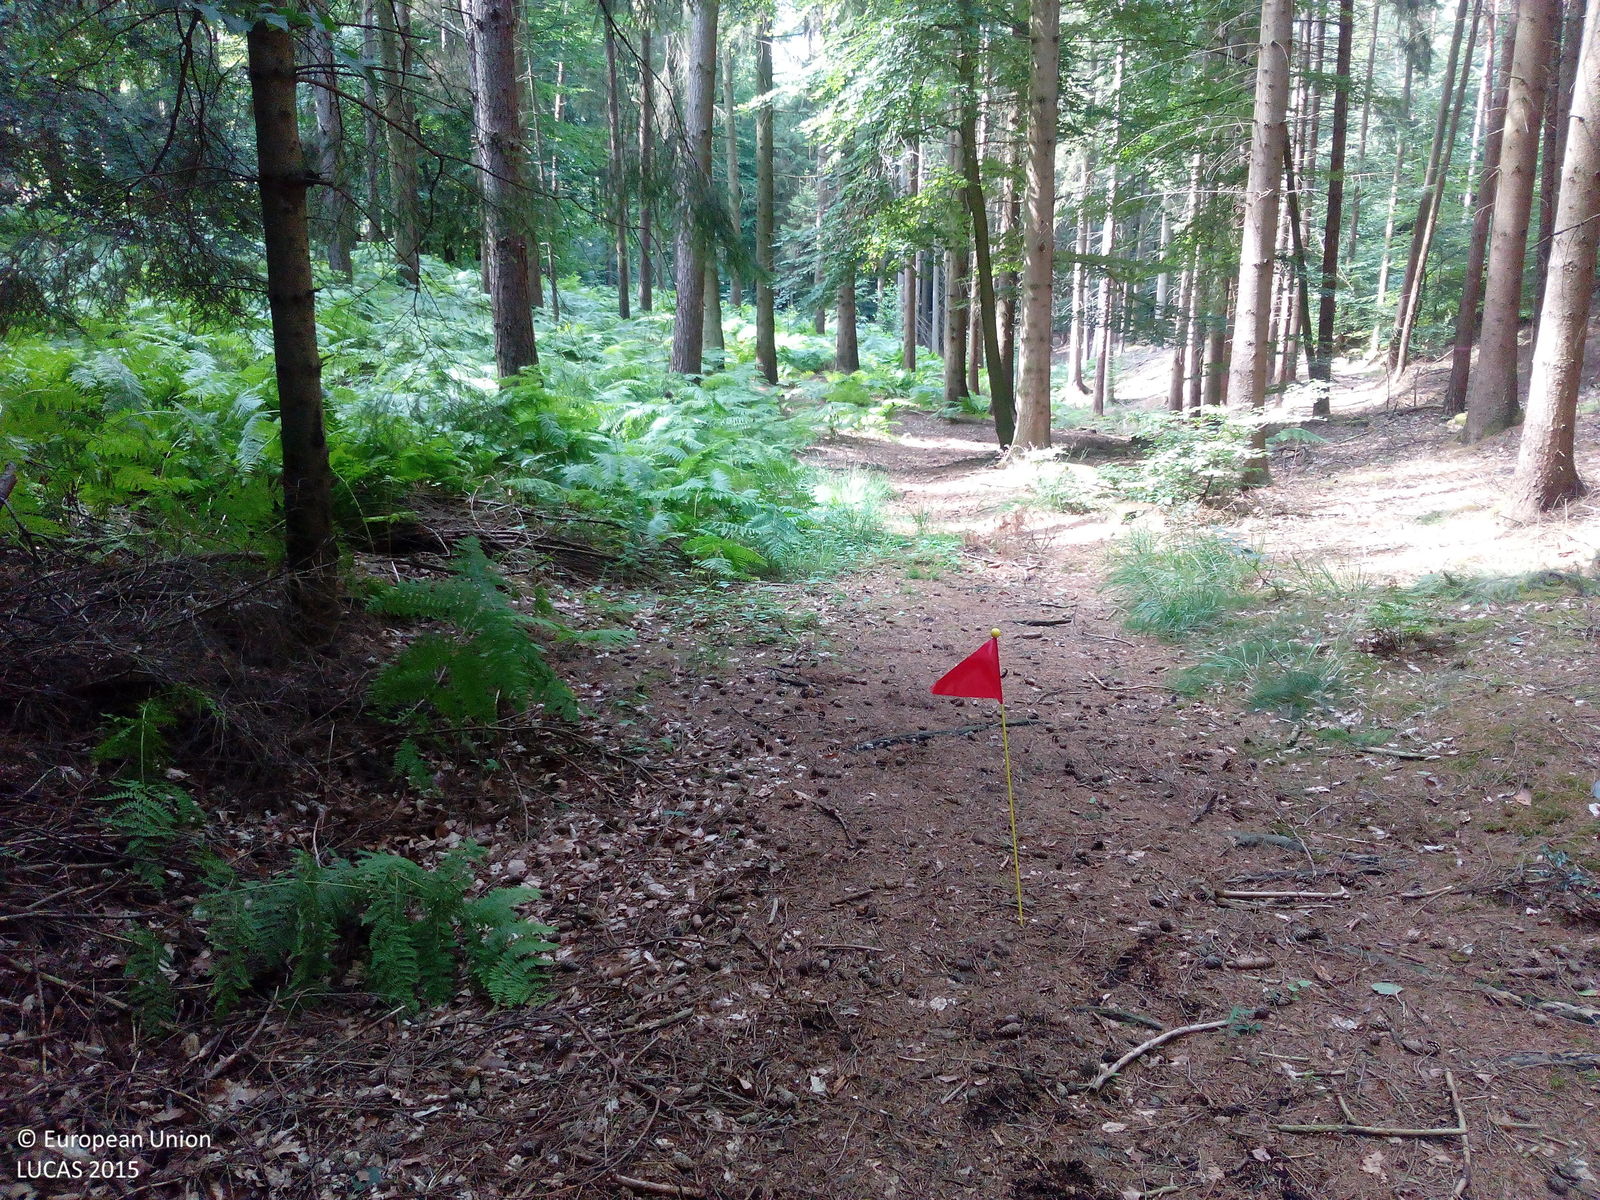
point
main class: Woodland
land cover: Spruce dominated mixed woodland
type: hemiboreal forest and nemoral coniferous forest and mixed broadleaved-coniferous forest
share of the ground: > 75 %
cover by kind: coniferous forest trees 45 %, broadleaved forest trees 45 %, shrubs 5 %, herbaceous plants 5 %
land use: Forestry
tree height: > 5 m
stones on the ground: < 10 %
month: August
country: DE
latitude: 52.3789
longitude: 8.0173
